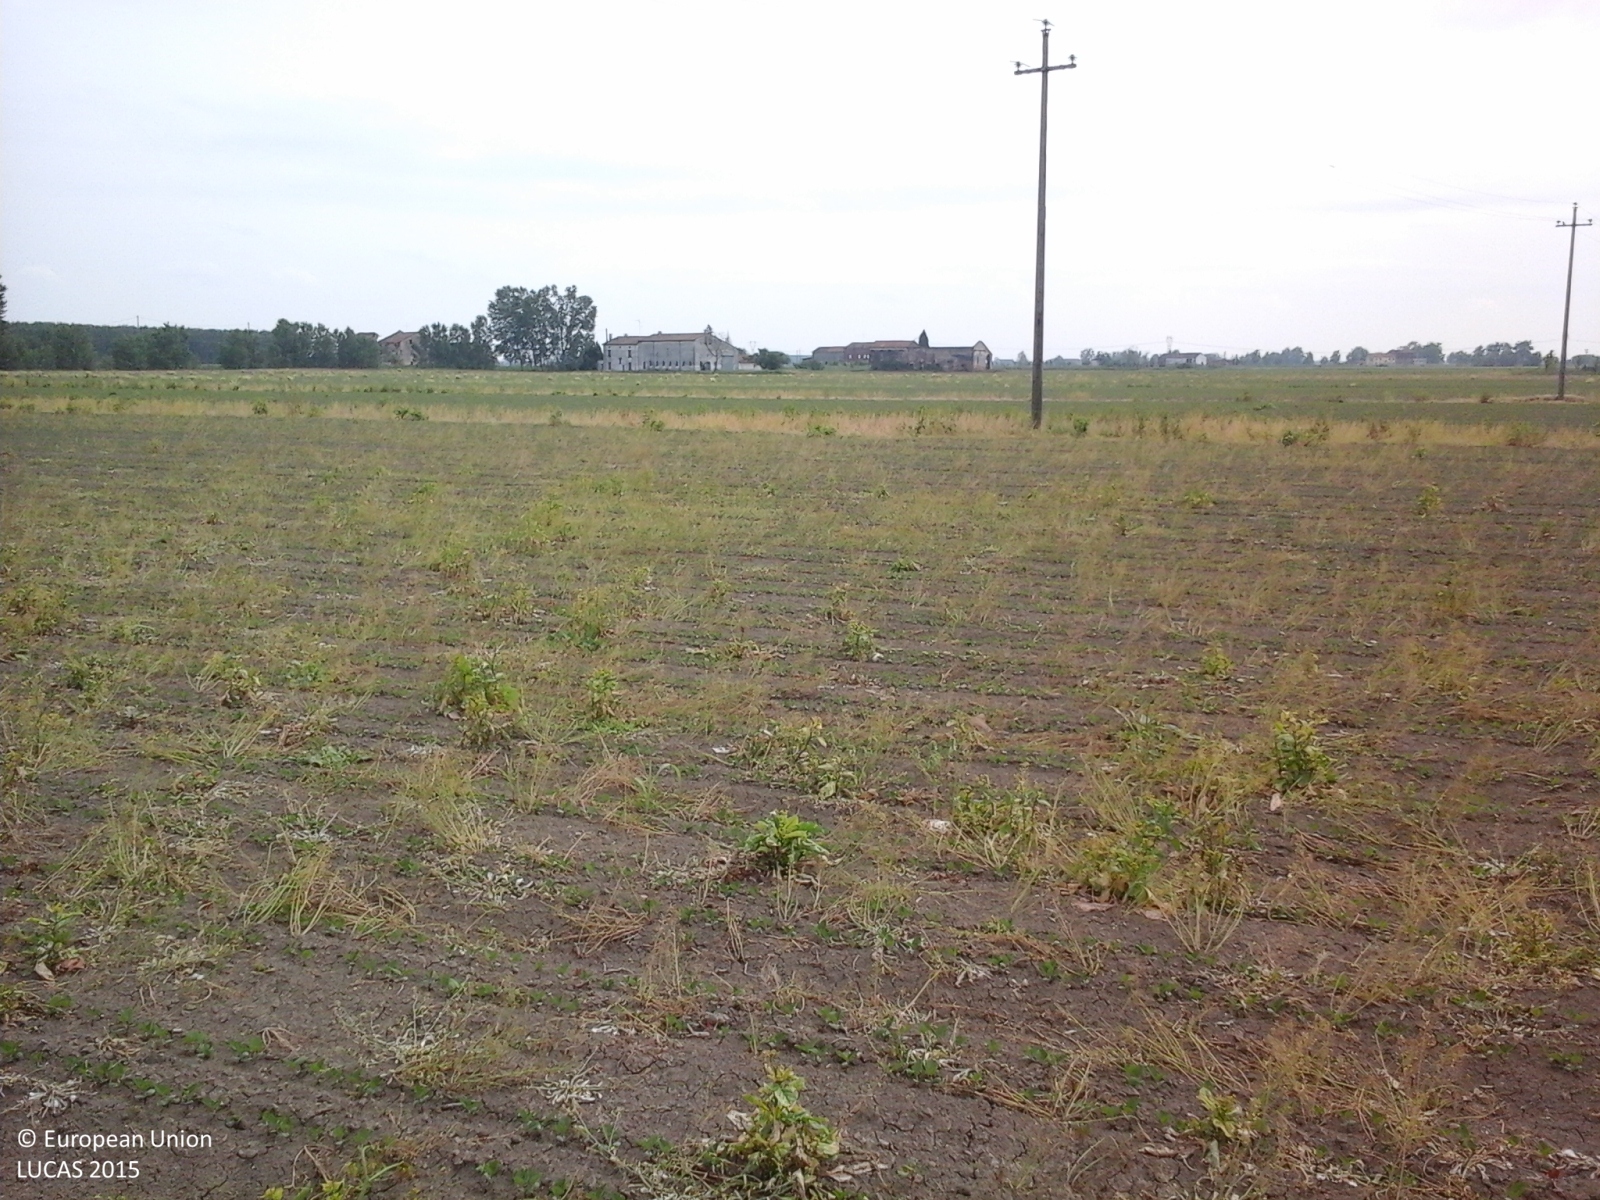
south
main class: Cropland
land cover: Soya
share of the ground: 10 - 25 %
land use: Agriculture (excluding fallow land and kitchen gardens)
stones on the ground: < 10 %
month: May
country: IT
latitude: 44.9979
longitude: 10.6204
